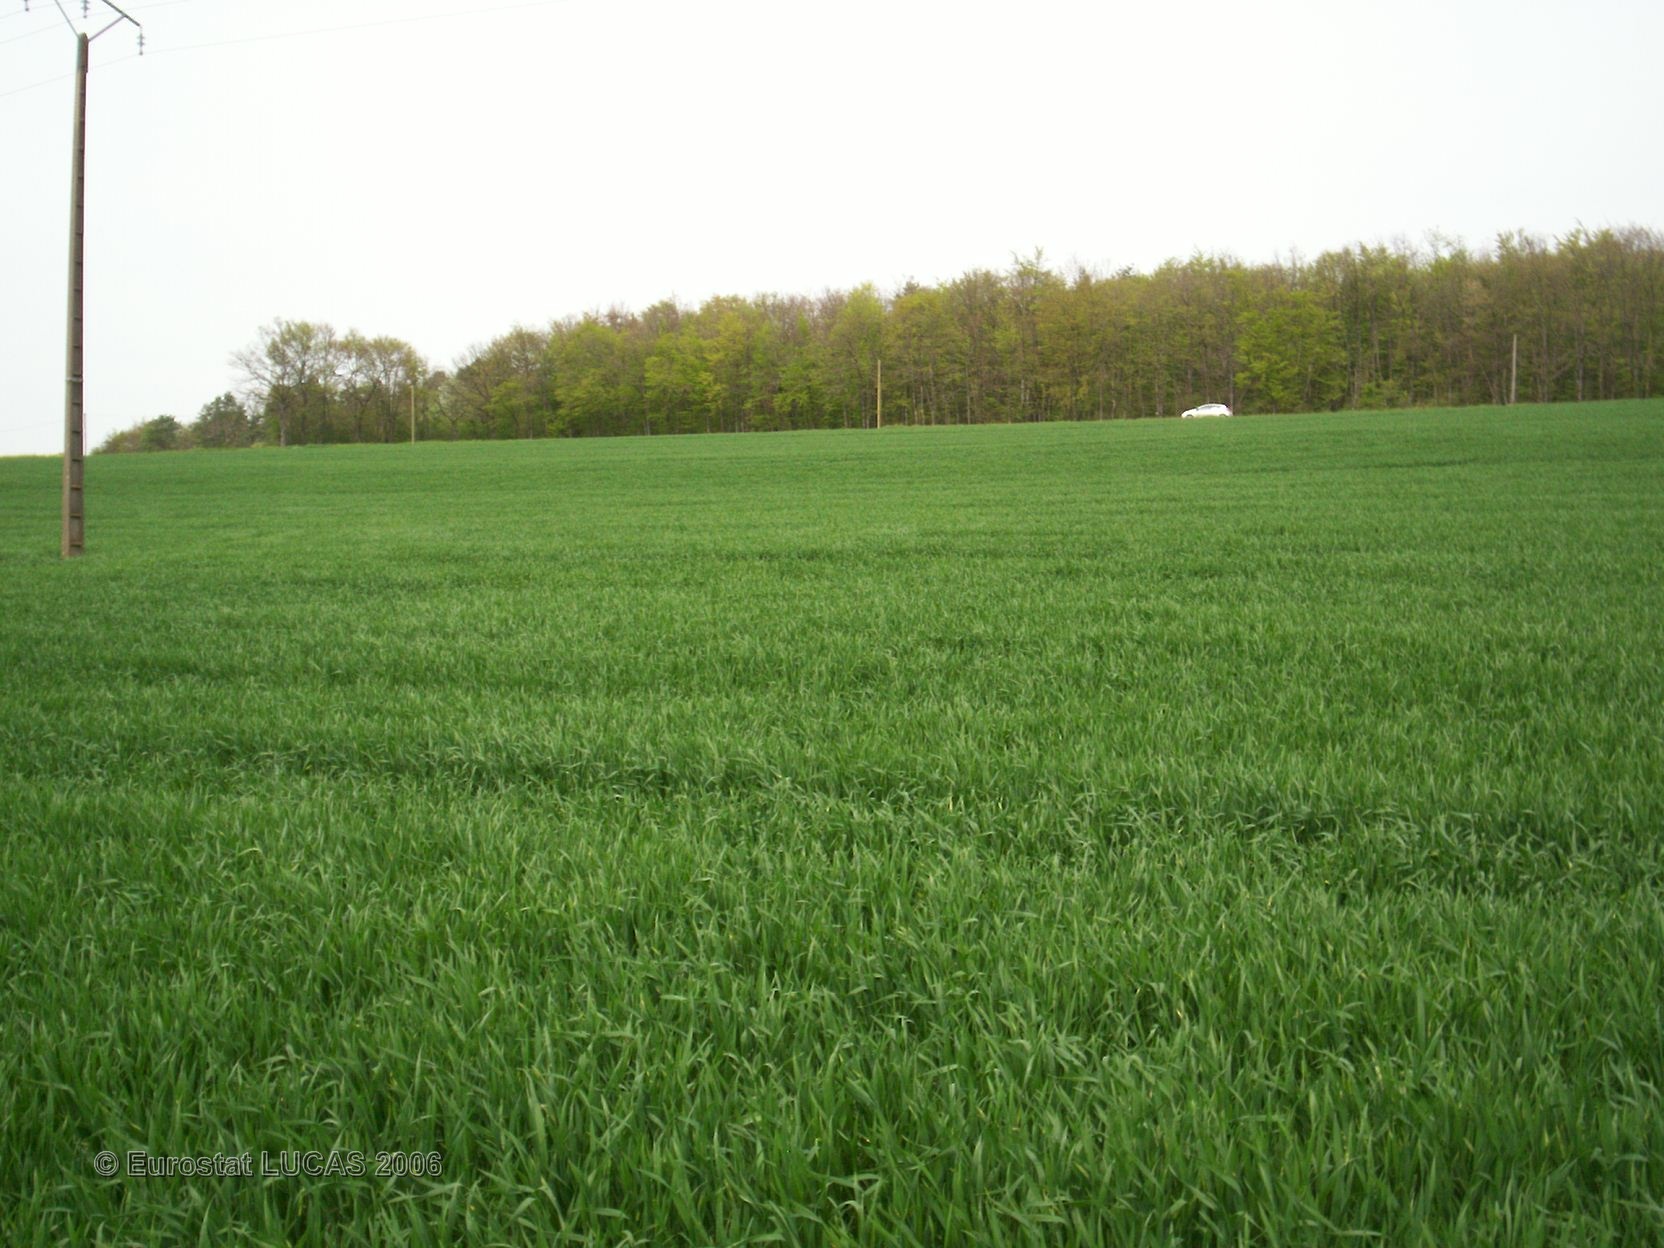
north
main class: Cropland
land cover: Common wheat
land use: Agriculture (excluding fallow land and kitchen gardens)
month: May
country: FR
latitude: 47.6740
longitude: 4.5513
